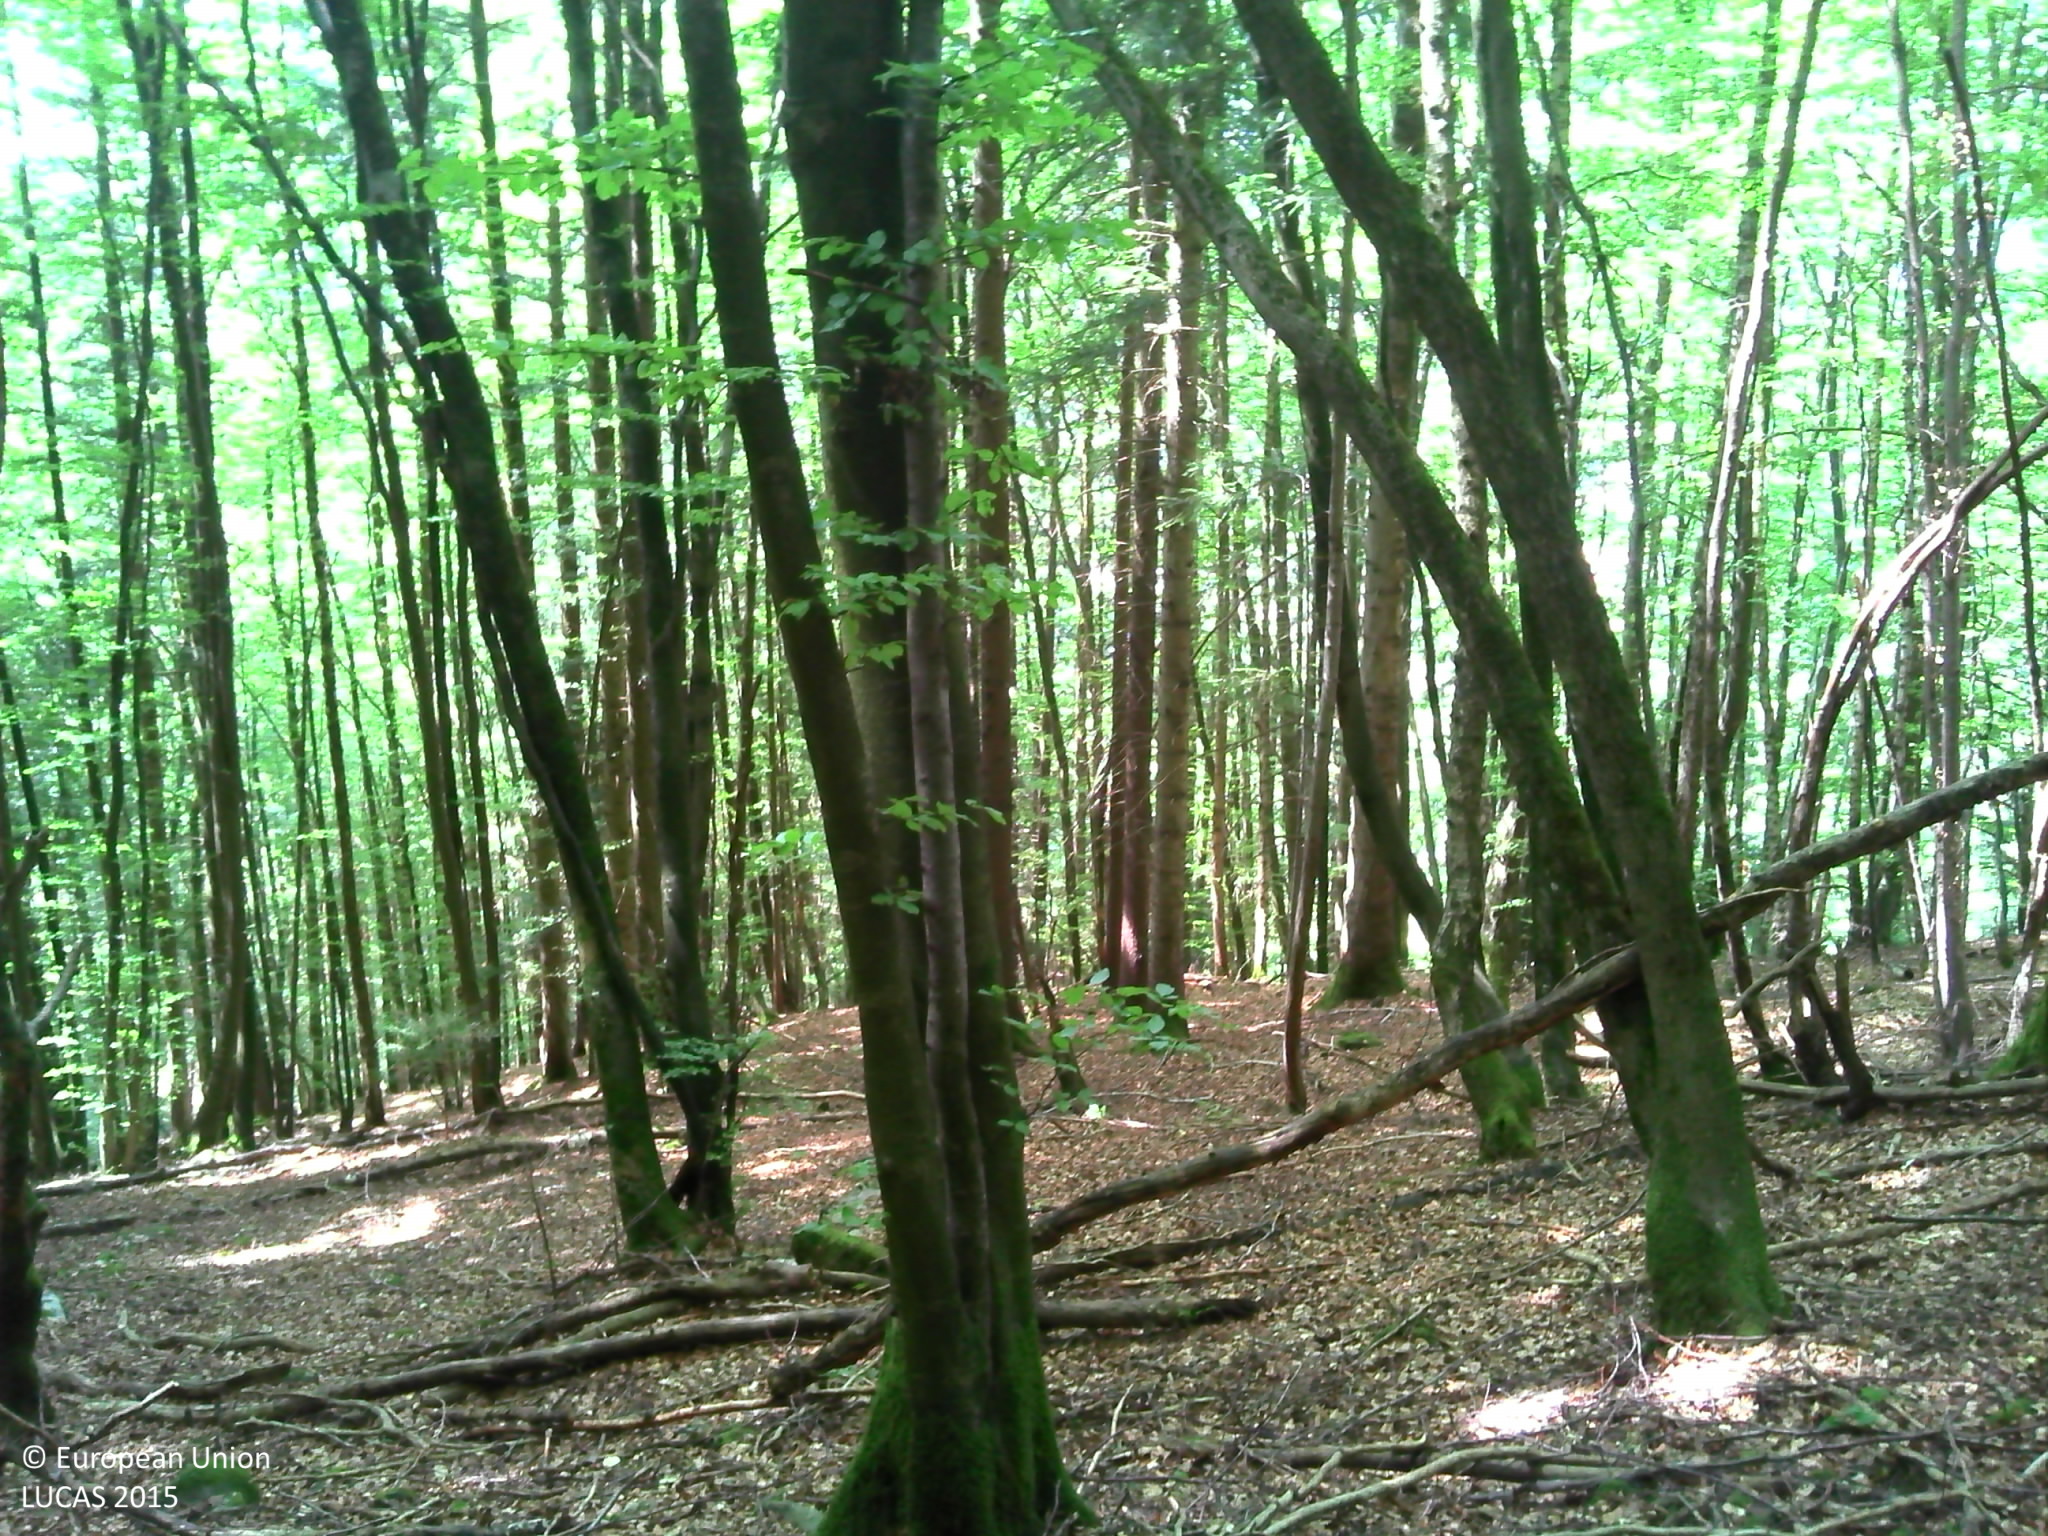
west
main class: Woodland
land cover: Broadleaved woodland
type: beech forest
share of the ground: > 75 %
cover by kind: broadleaved forest trees 75 %, coniferous forest trees 15 %, herbaceous plants 5 %, lichens and mosses 5 %
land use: Forestry
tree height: > 5 m
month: July
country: FR
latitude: 46.1307
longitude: 6.4701
